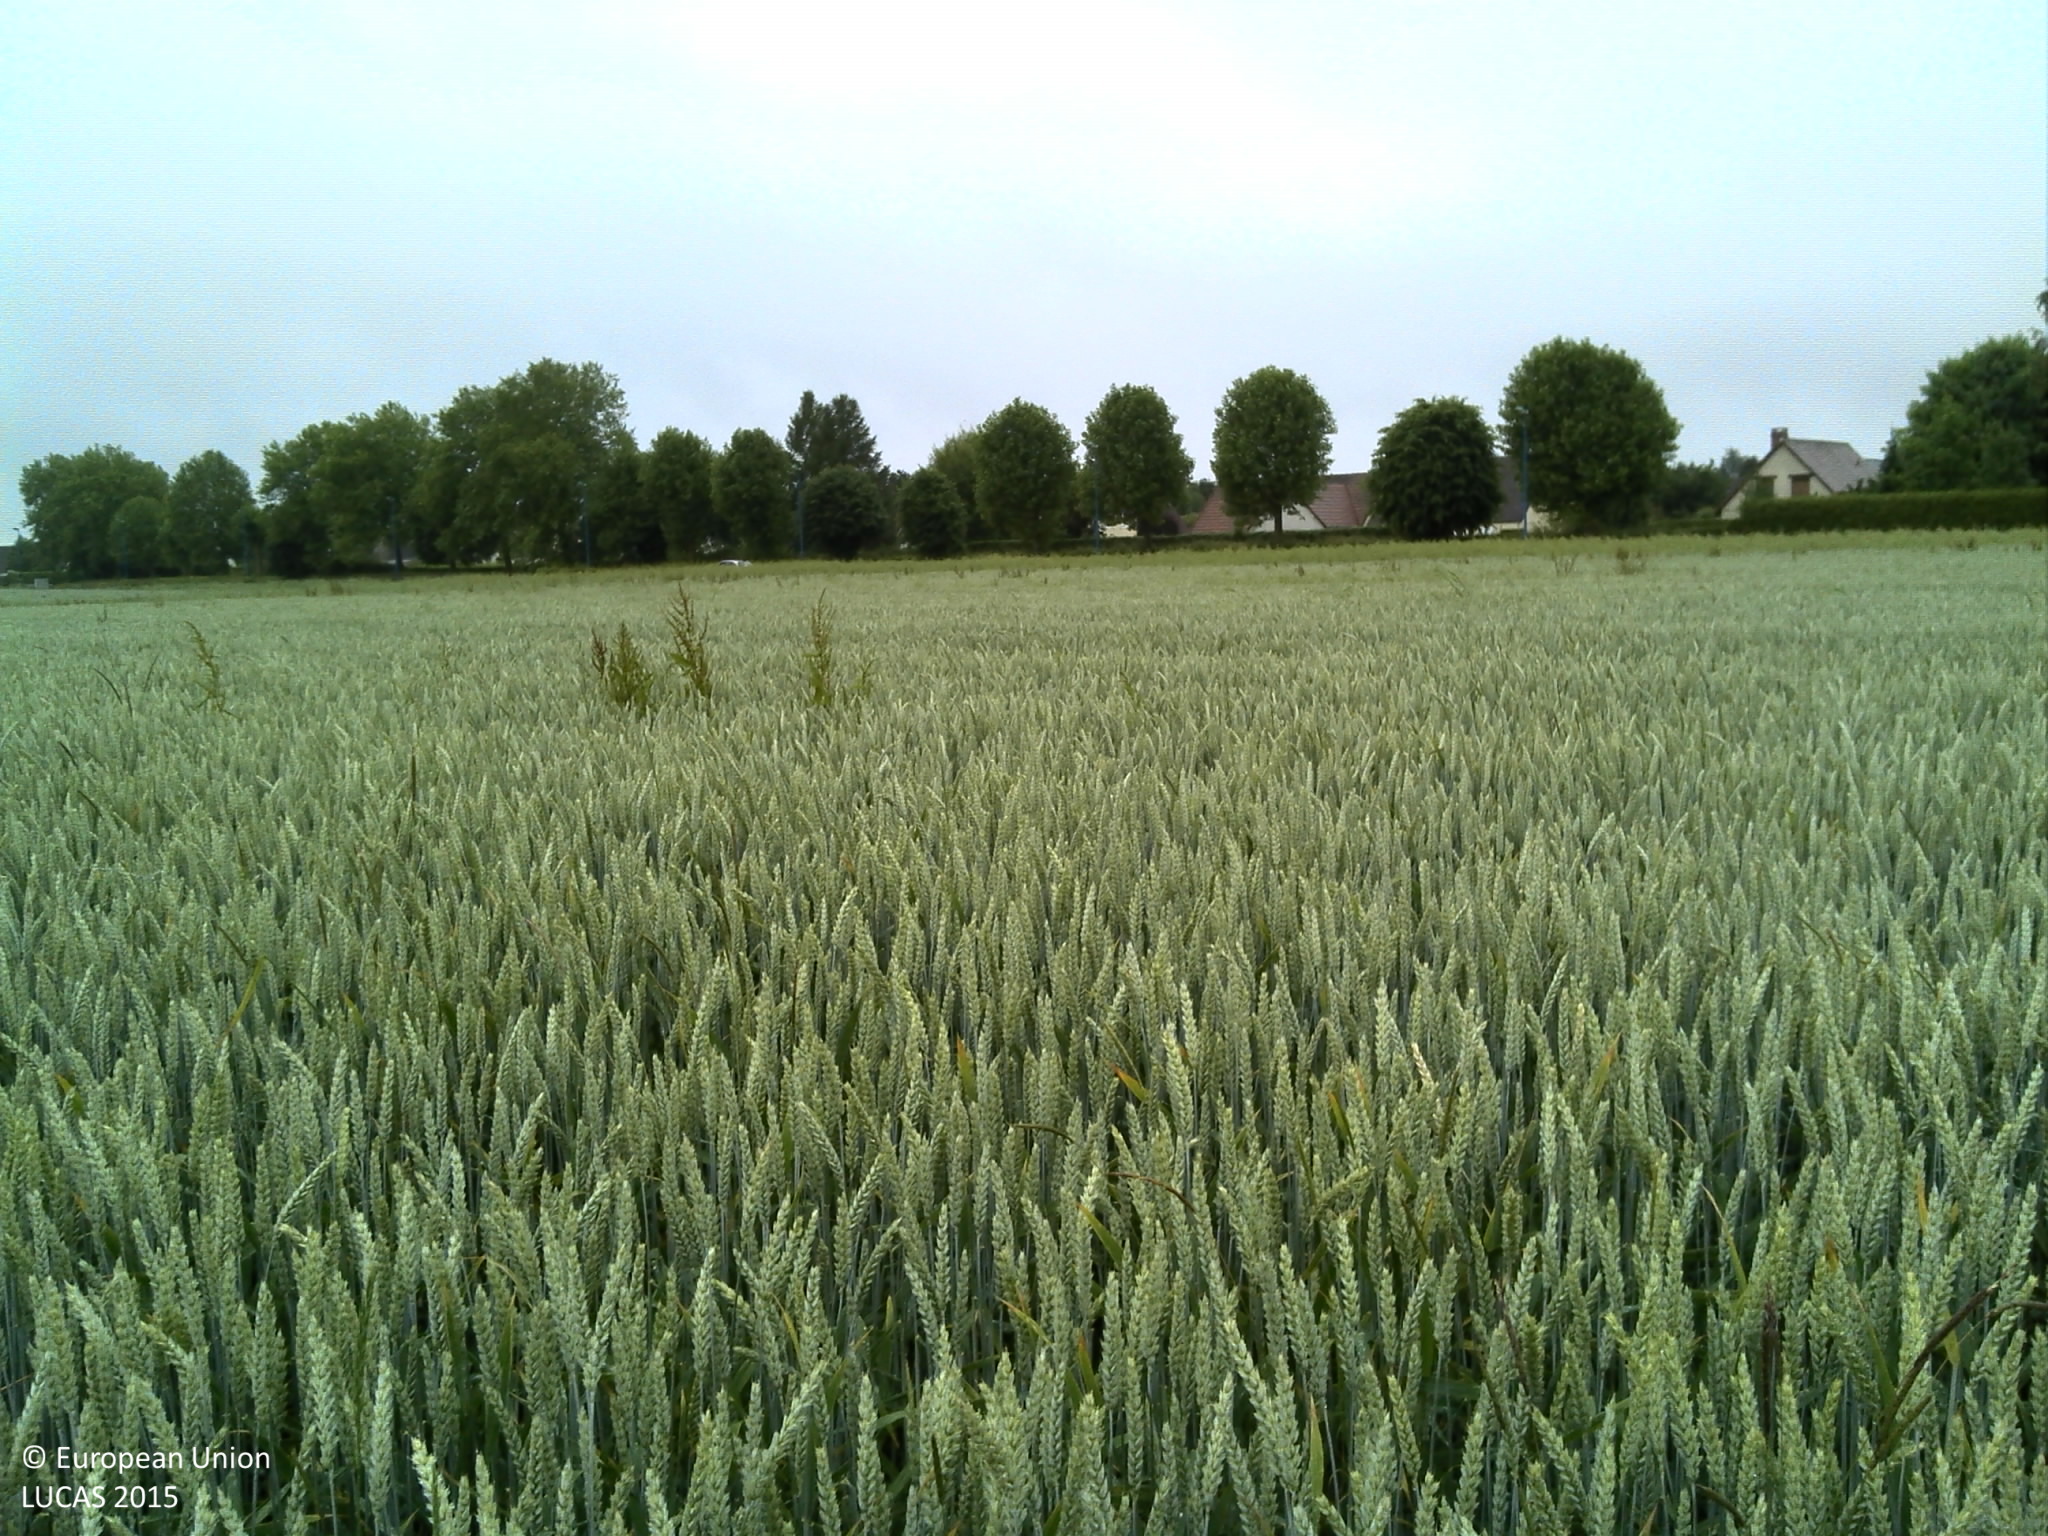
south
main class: Cropland
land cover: Common wheat
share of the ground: > 75 %
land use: Agriculture (excluding fallow land and kitchen gardens)
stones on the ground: 10 - 25 %
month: June
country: FR
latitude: 49.4228
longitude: 1.1419
